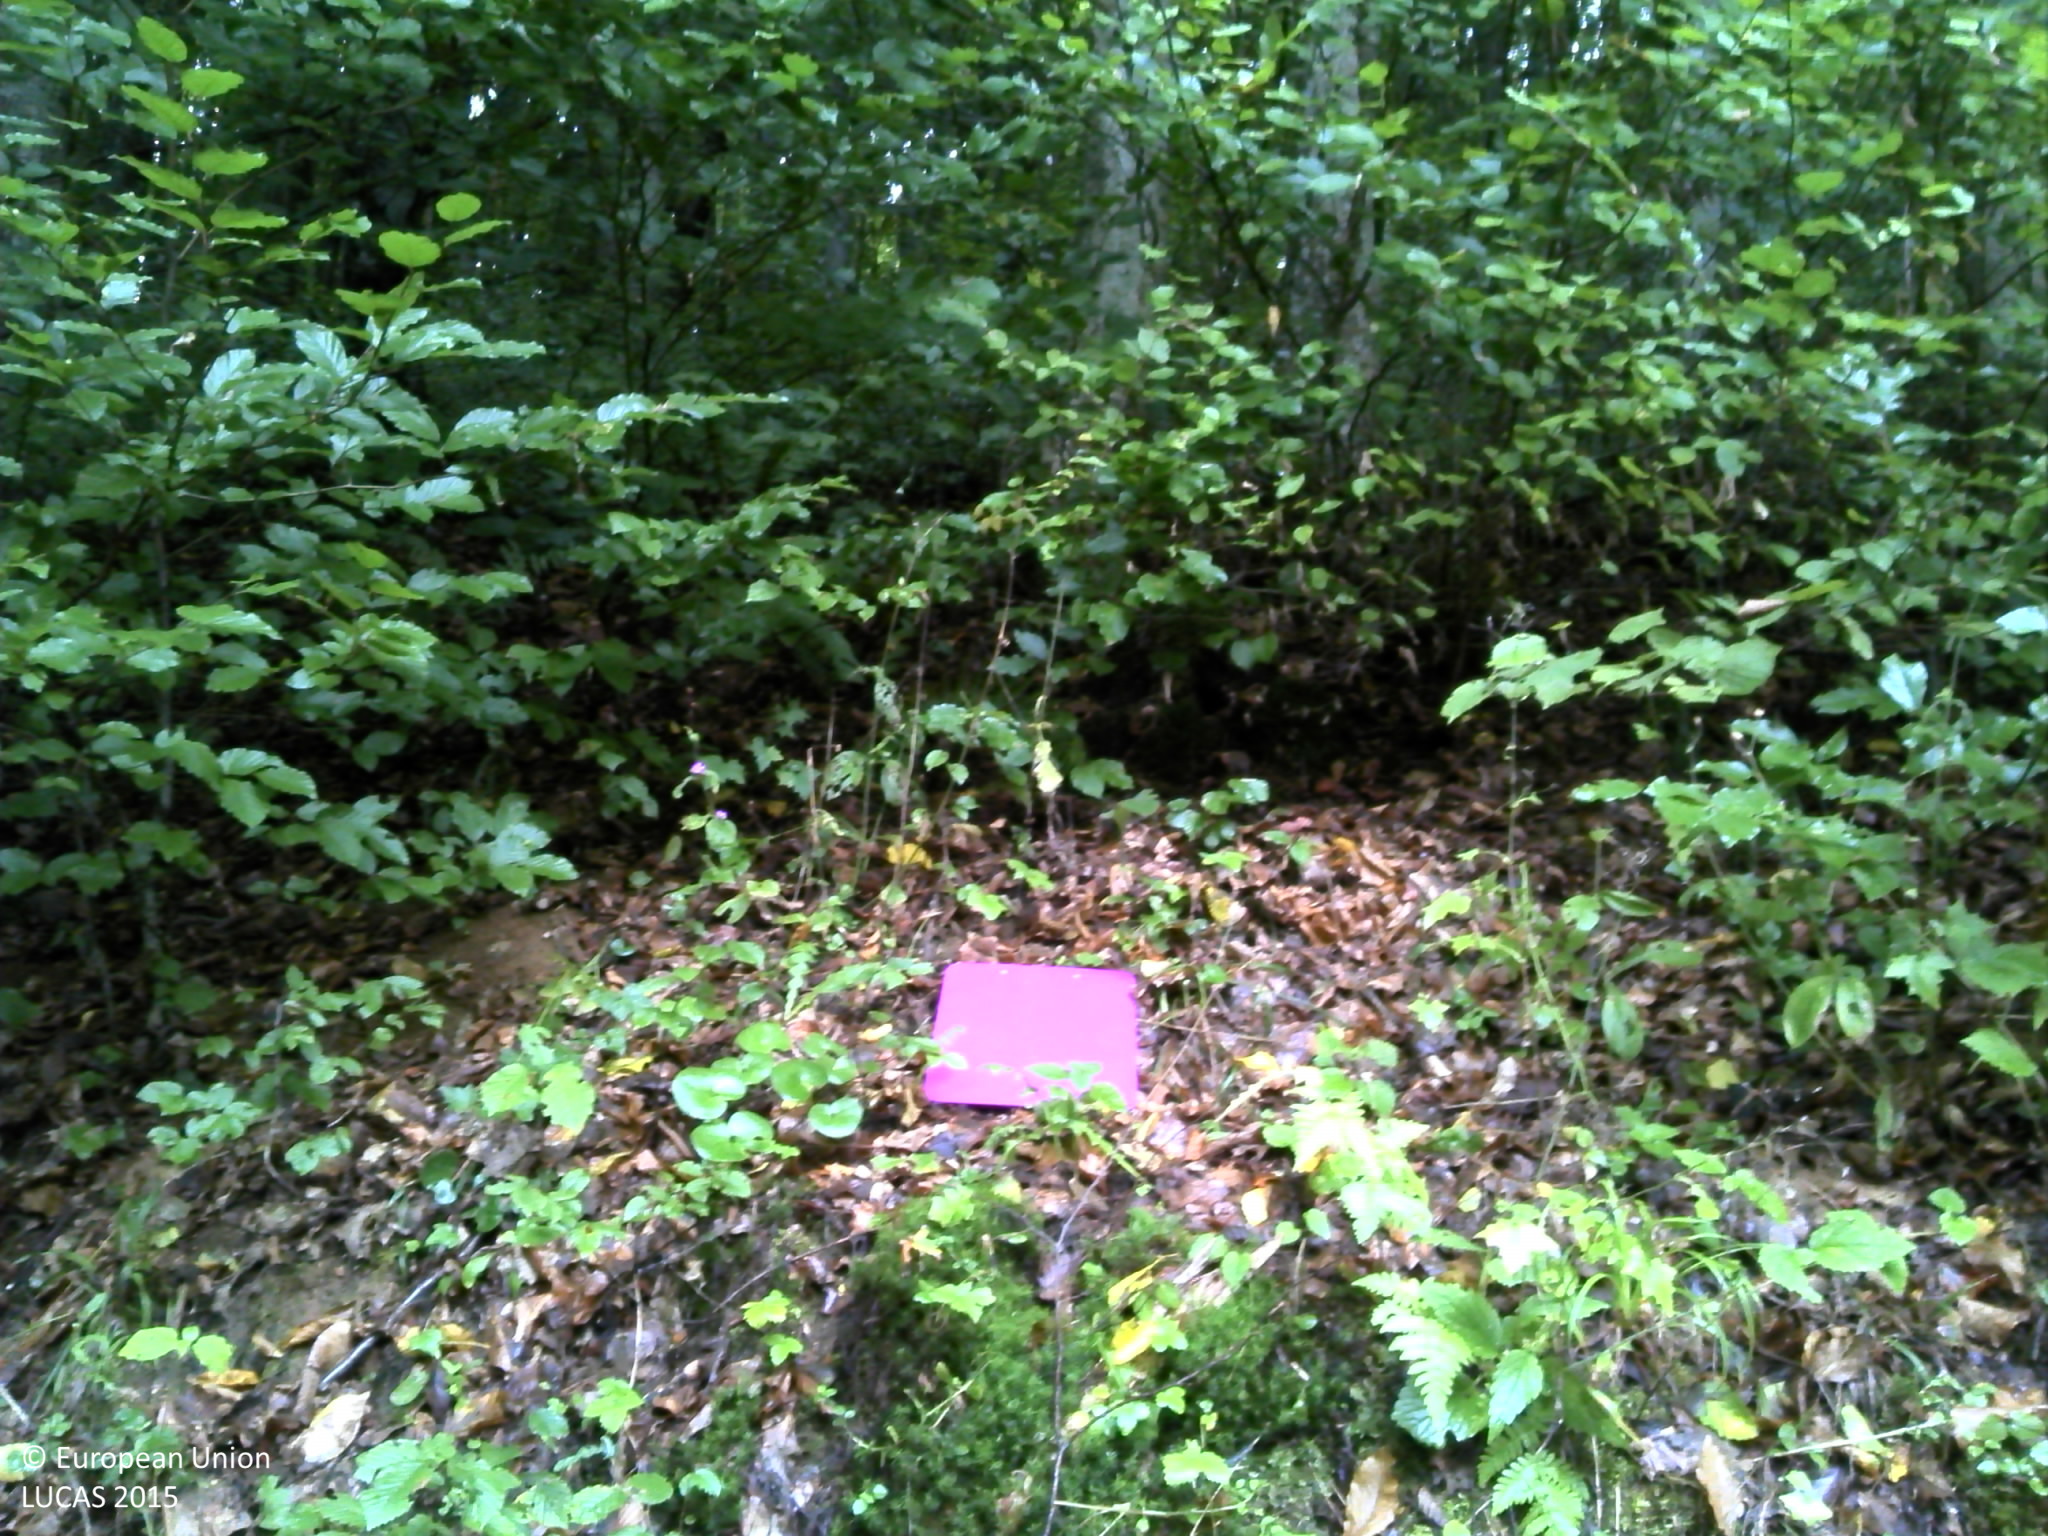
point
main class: Woodland
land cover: Broadleaved woodland
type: beech forest
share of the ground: > 75 %
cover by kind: broadleaved forest trees 100 %
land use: Forestry
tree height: > 5 m
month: August
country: HR
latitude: 45.3724
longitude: 15.6271
